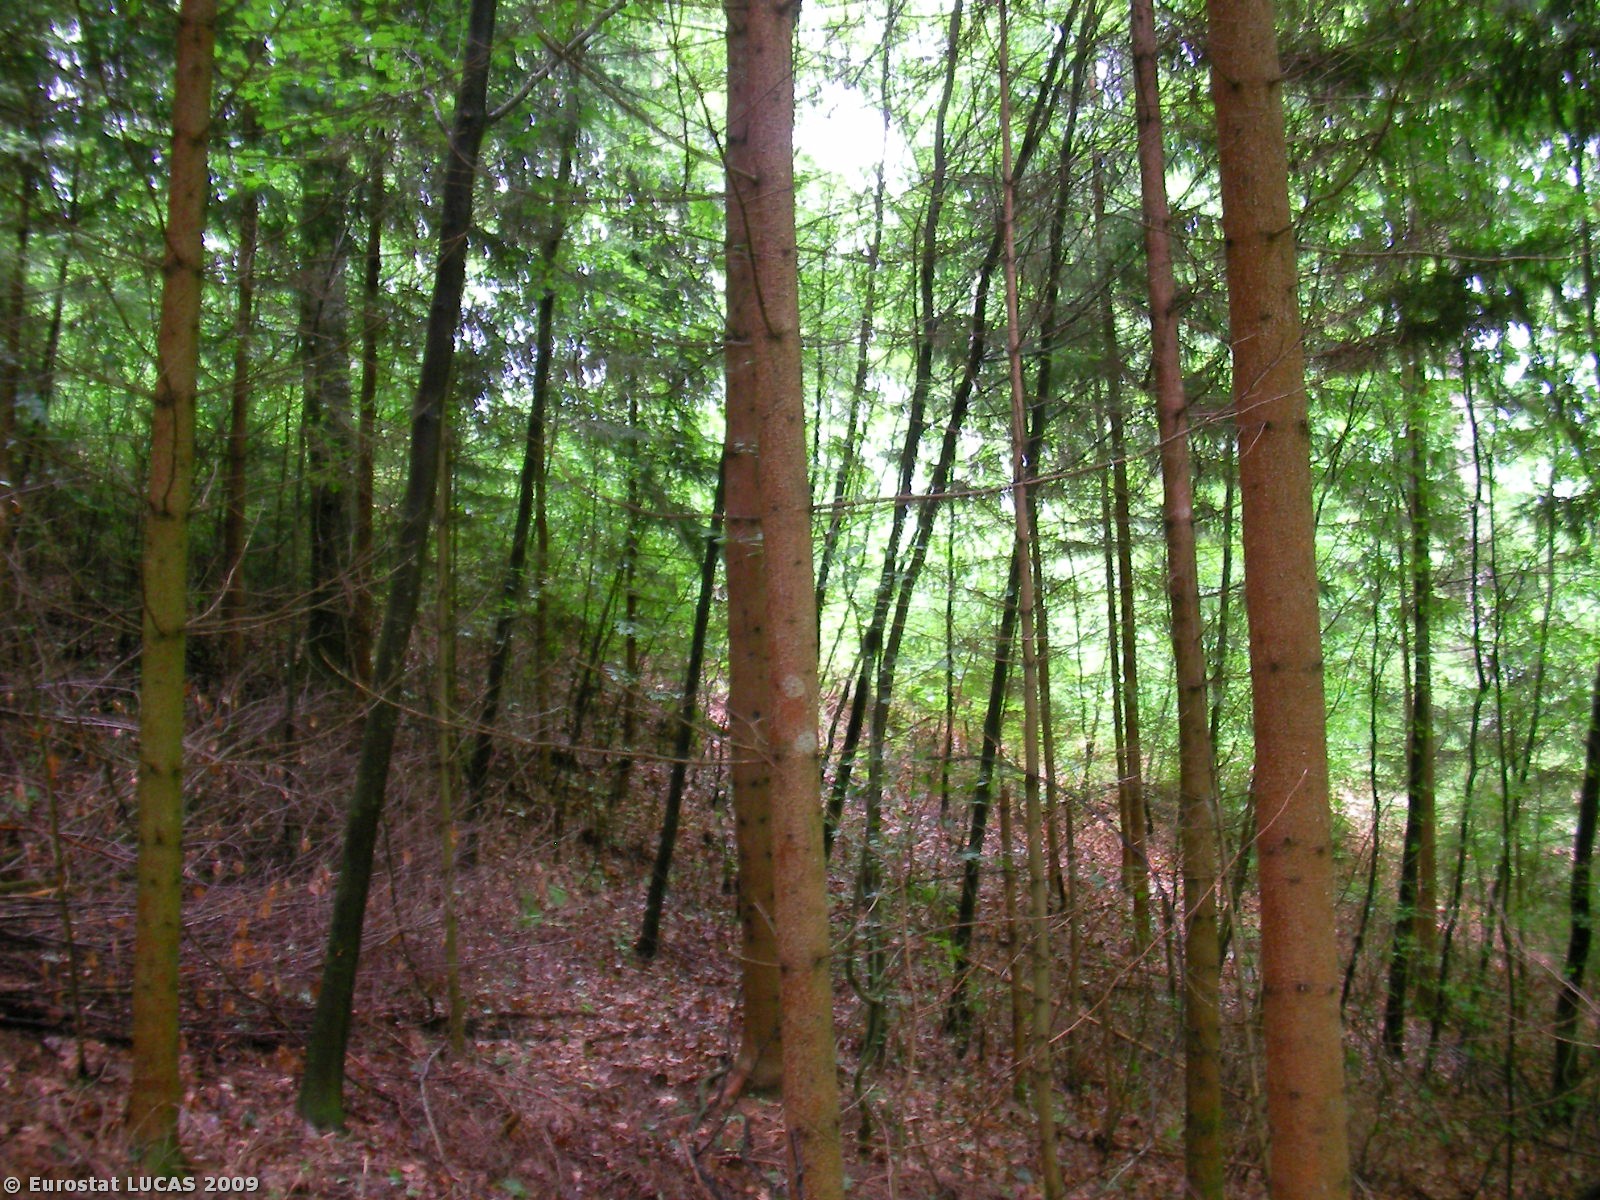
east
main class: Woodland
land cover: Mixed woodland
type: hemiboreal forest and nemoral coniferous forest and mixed broadleaved-coniferous forest
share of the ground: > 75 %
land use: Forestry
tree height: > 5 m
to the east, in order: Mixed woodland; Inland water bodies; Broadleaved woodland; Grassland without tree/shrub cover; Managed hedges; Fences; Apple fruit; Grassland with sparse tree/shrub cover; Fences; Grassland without tree/shrub cover; Managed hedges; Grassland without tree/shrub cover; Single bushes/trees; Grassland without tree/shrub cover; Fences; Grassland without tree/shrub cover; Mixed woodland
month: June
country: AT
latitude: 47.1360
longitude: 15.7360
